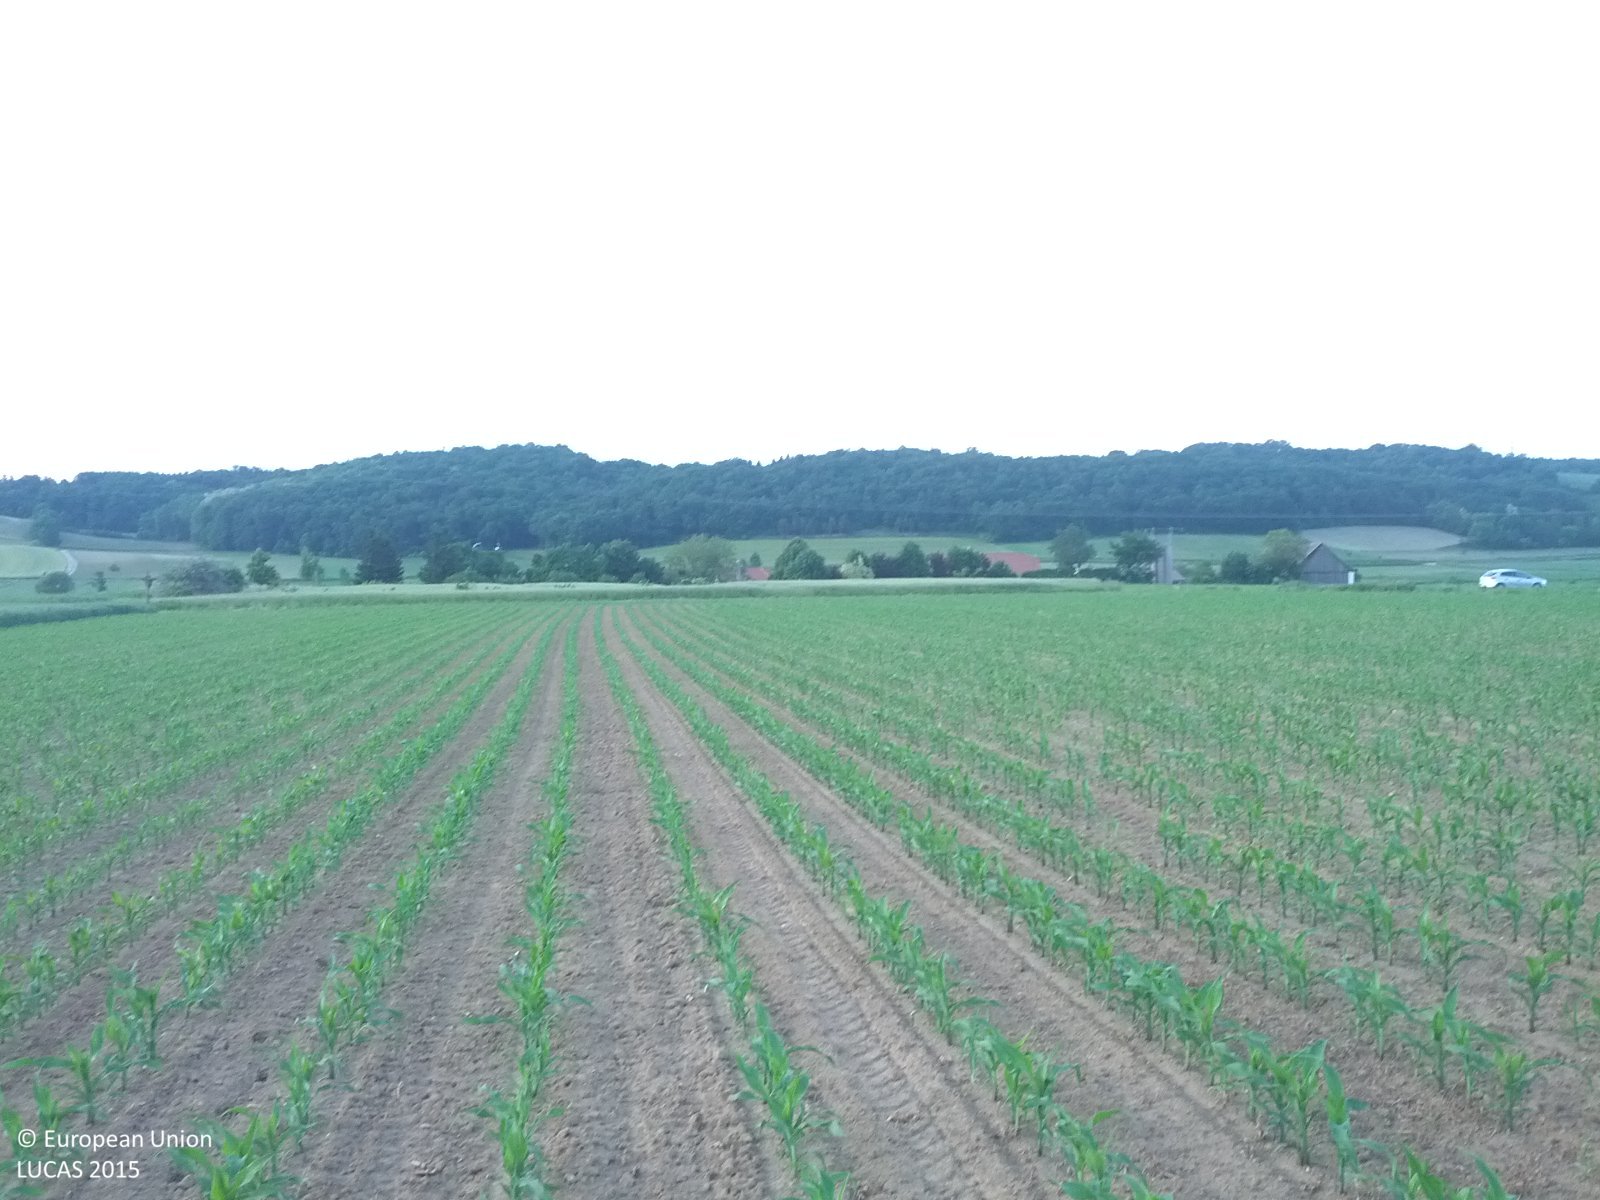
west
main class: Cropland
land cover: Maize
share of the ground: < 10 %
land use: Agriculture (excluding fallow land and kitchen gardens)
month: May
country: AT
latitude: 48.2466
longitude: 15.8884
